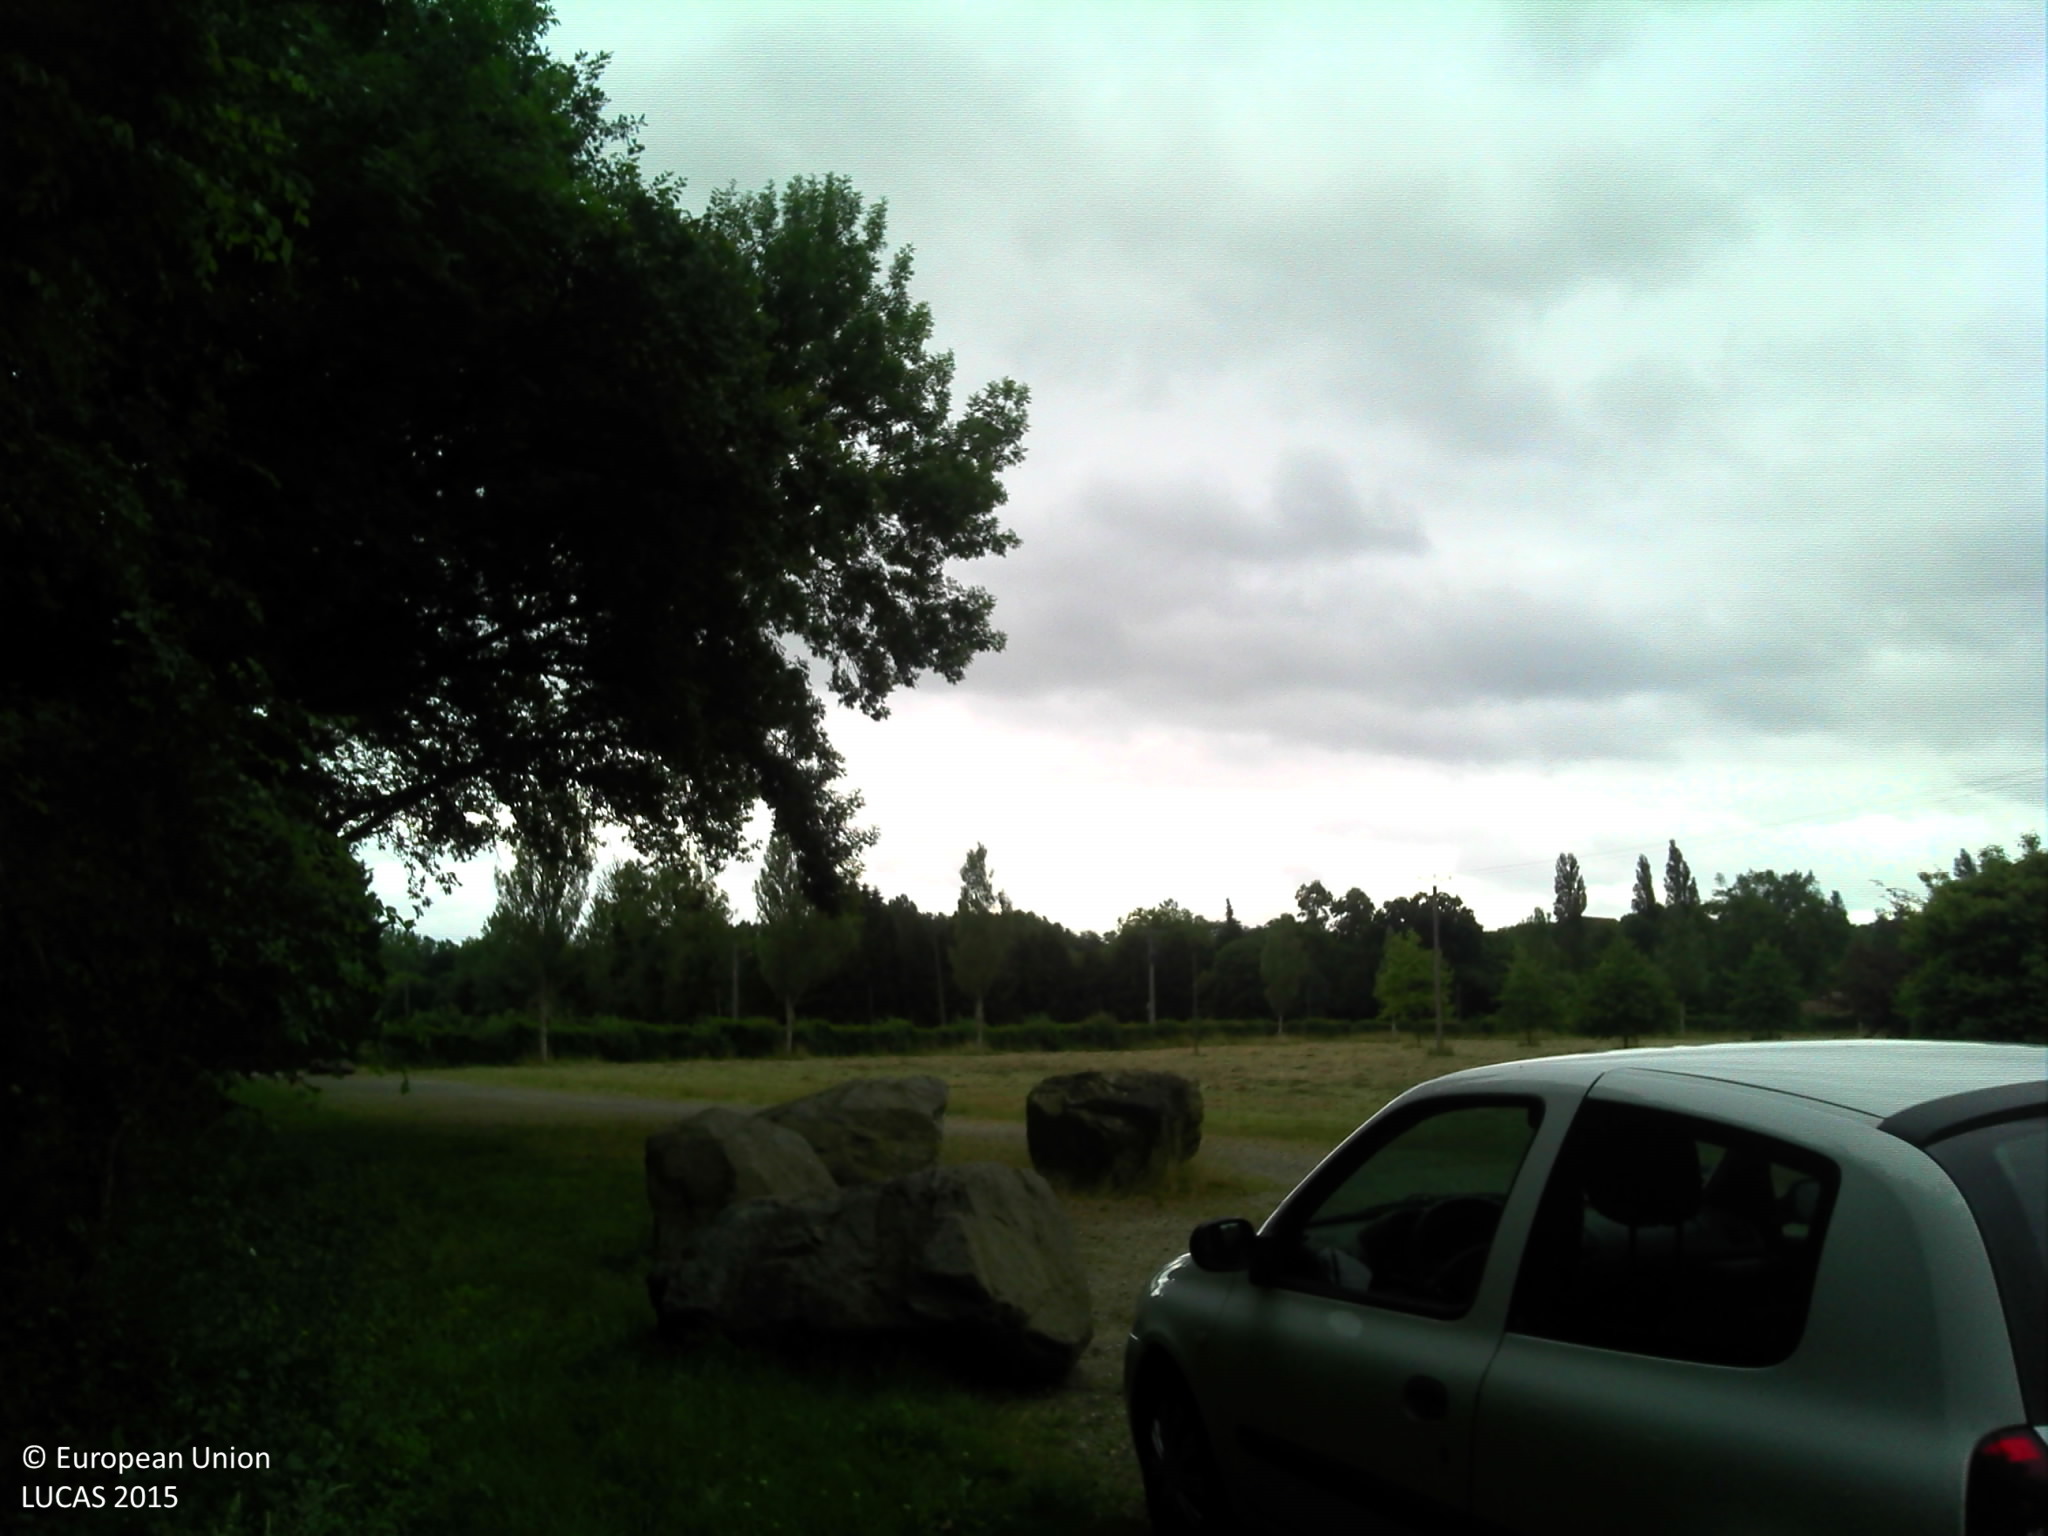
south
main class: Grassland
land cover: Grassland with sparse tree/shrub cover
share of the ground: > 75 %
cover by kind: herbaceous plants 95 %, broadleaved forest trees 5 %
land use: Residential
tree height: > 5 m
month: June
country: FR
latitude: 48.0749
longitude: 0.1890
